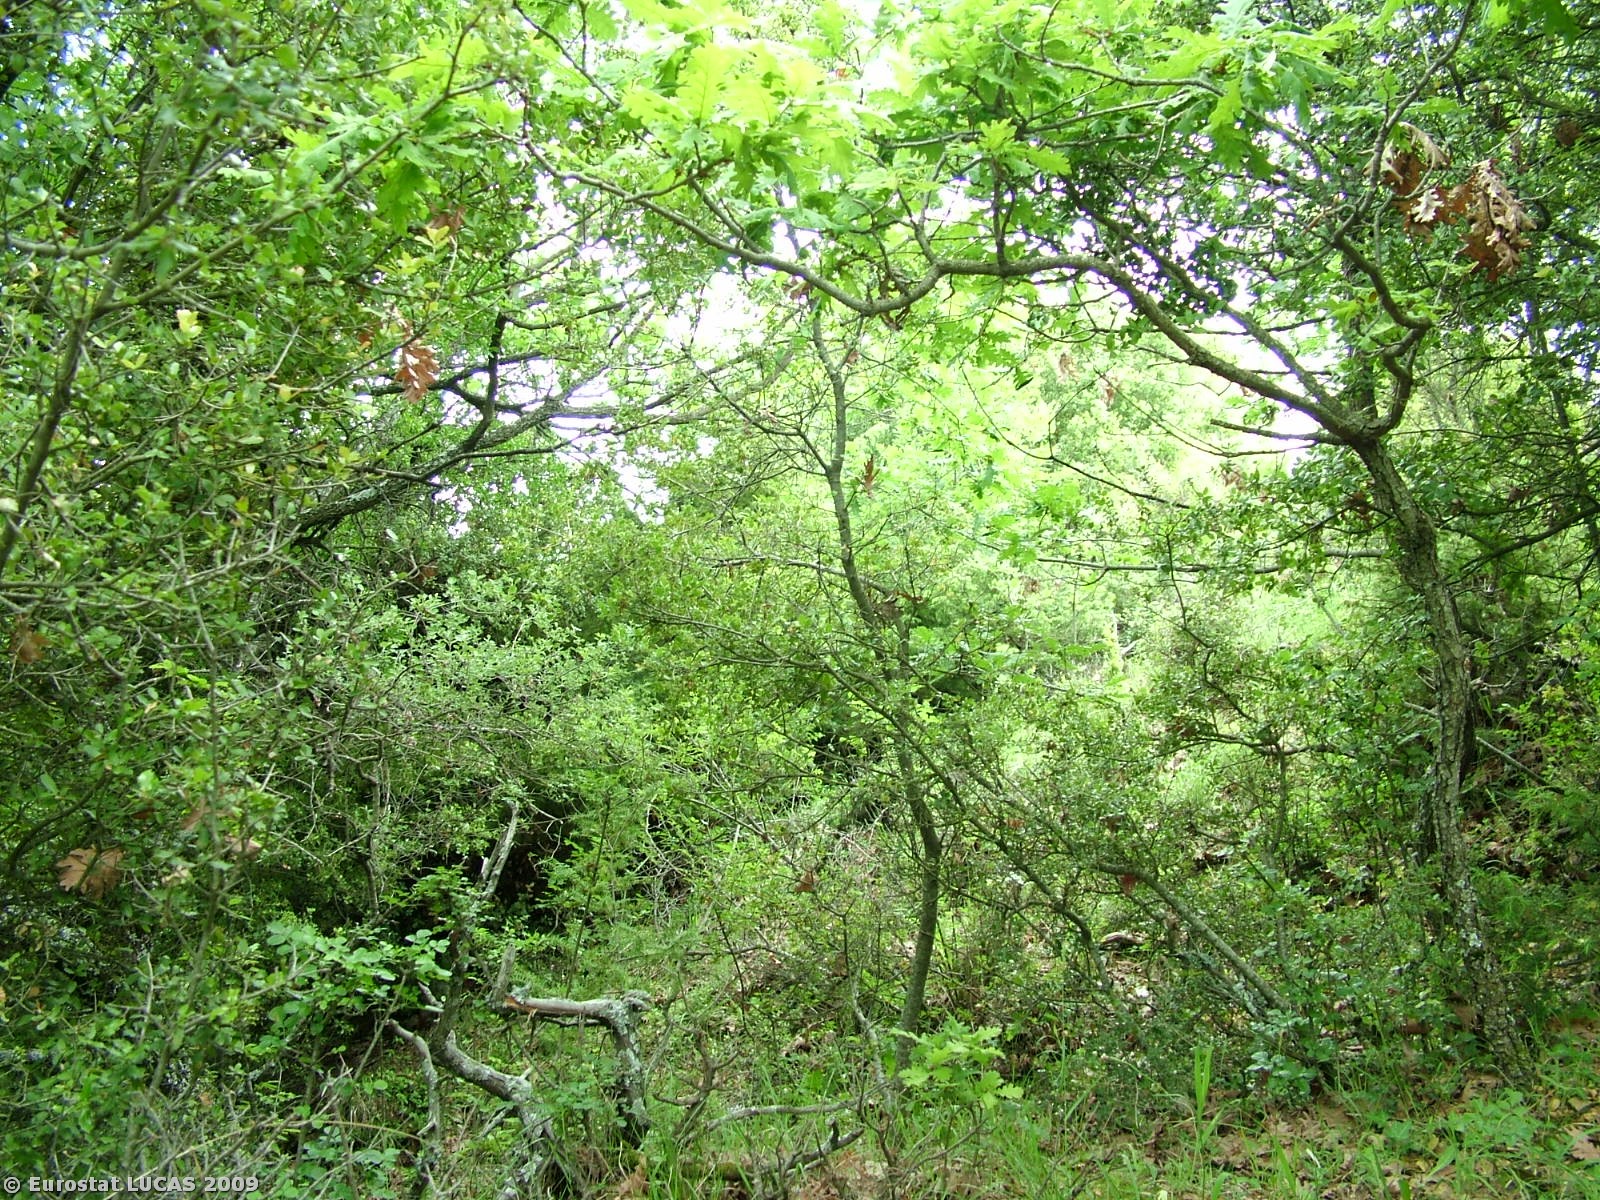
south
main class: Woodland
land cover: Broadleaved woodland
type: thermophilous deciduous forest
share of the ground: > 75 %
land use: Agriculture (excluding fallow land and kitchen gardens)
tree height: > 5 m
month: May
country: GR
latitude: 41.1129
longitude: 24.6007
